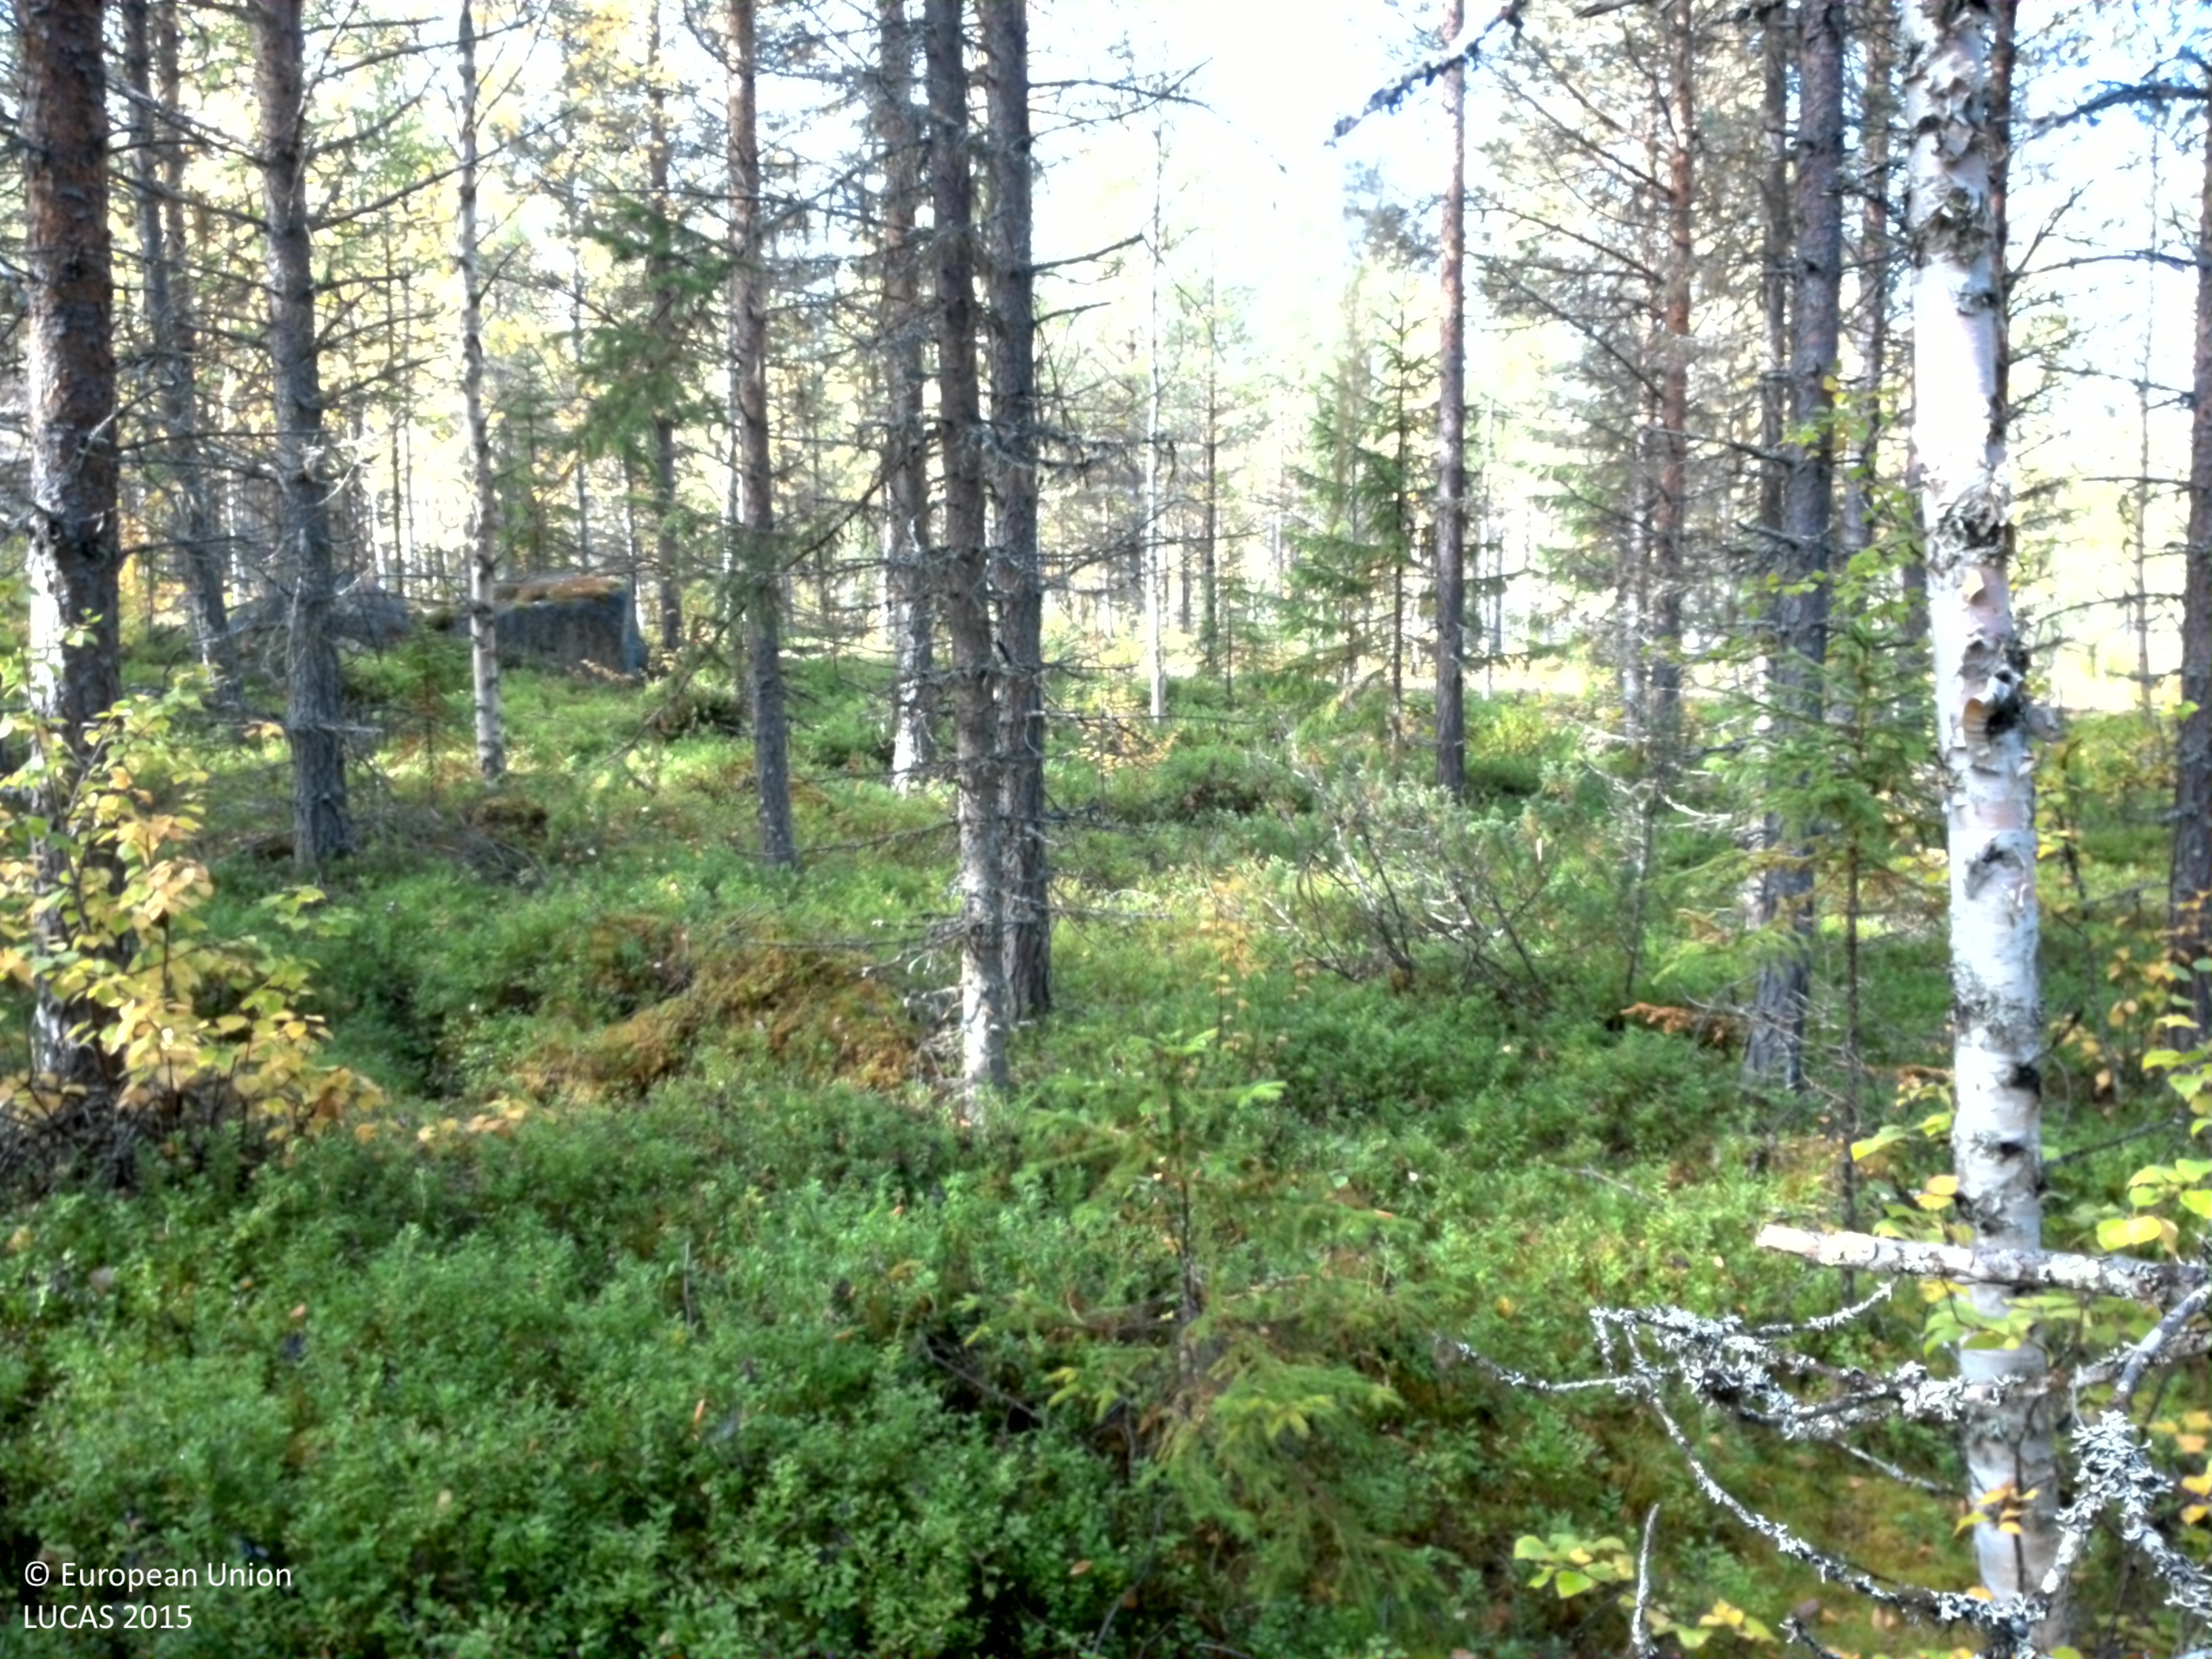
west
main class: Woodland
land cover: Pine dominated coniferous woodland
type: boreal forest
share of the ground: 25 - 50 %
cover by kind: shrubs 45 %, coniferous forest trees 30 %, herbaceous plants 10 %, lichens and mosses 10 %, broadleaved forest trees 5 %
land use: Forestry
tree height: > 5 m
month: September
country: SE
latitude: 65.2180
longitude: 16.6979
